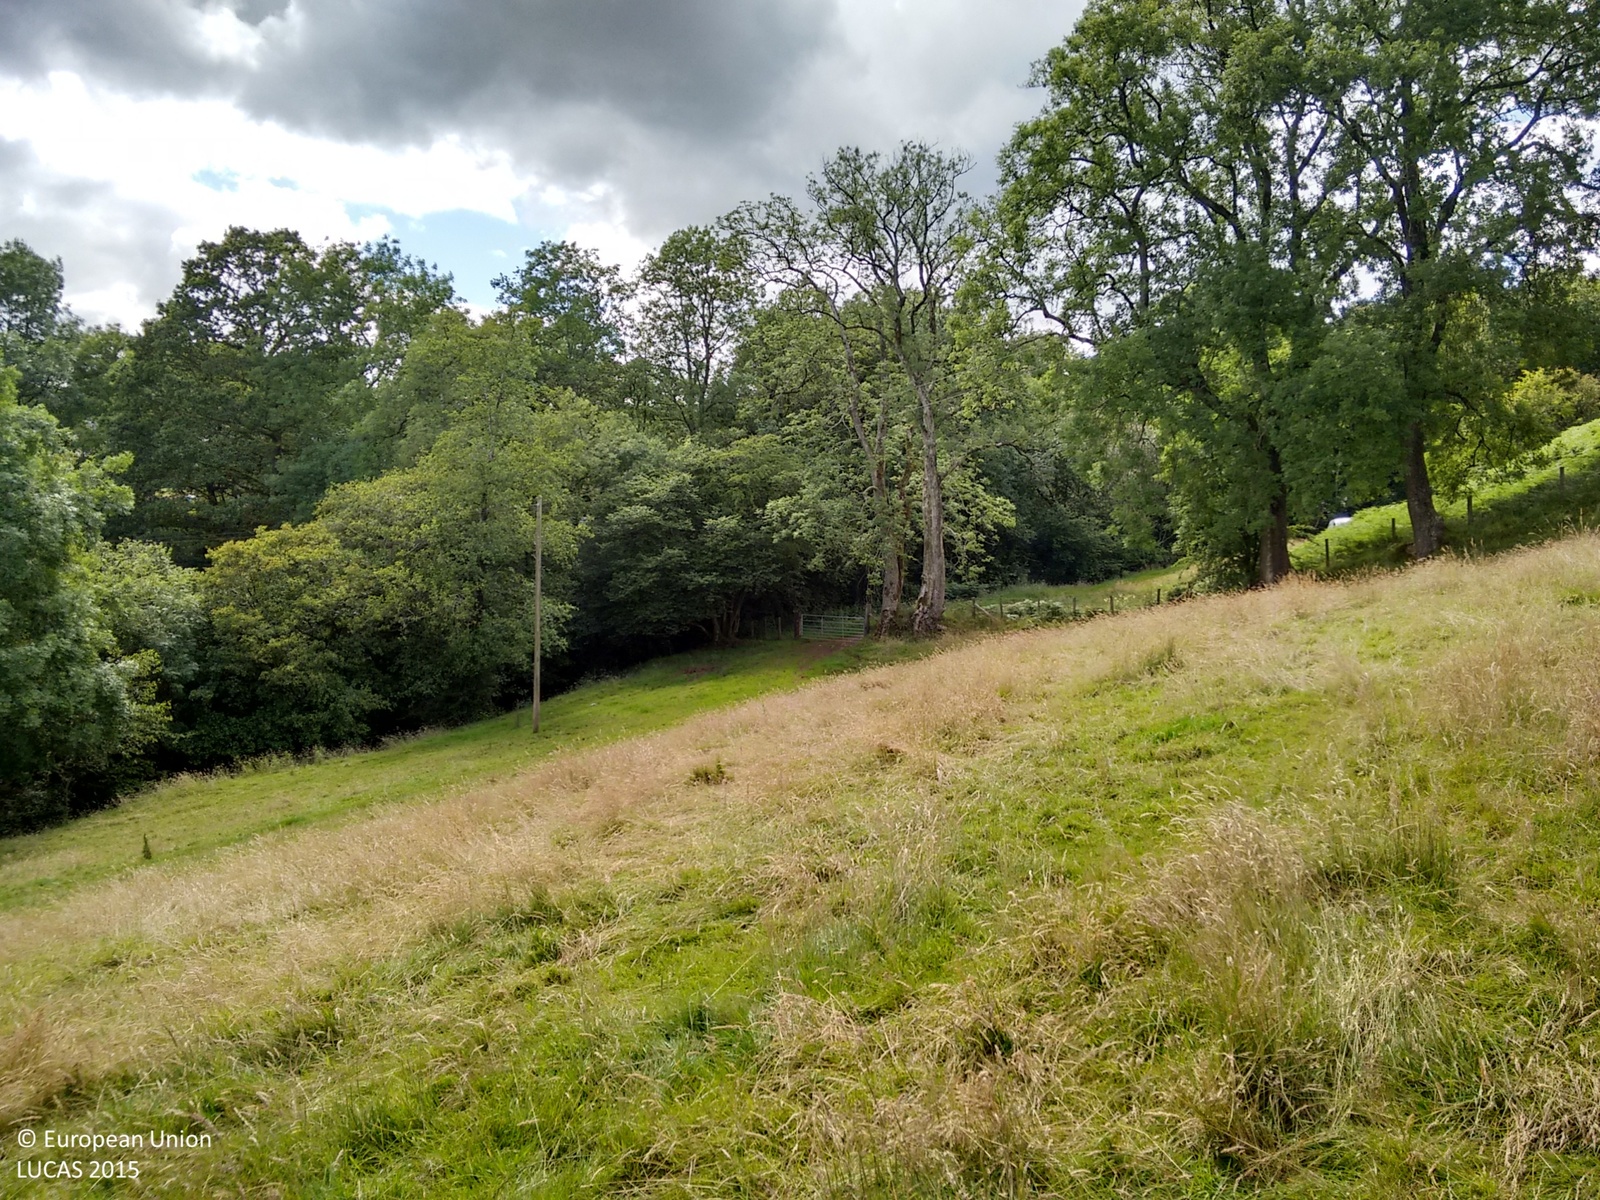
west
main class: Grassland
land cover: Grassland without tree/shrub cover
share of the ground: > 75 %
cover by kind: herbaceous plants 100 %
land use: Agriculture (excluding fallow land and kitchen gardens)
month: July
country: GB
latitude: 51.8854
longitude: -3.8798
